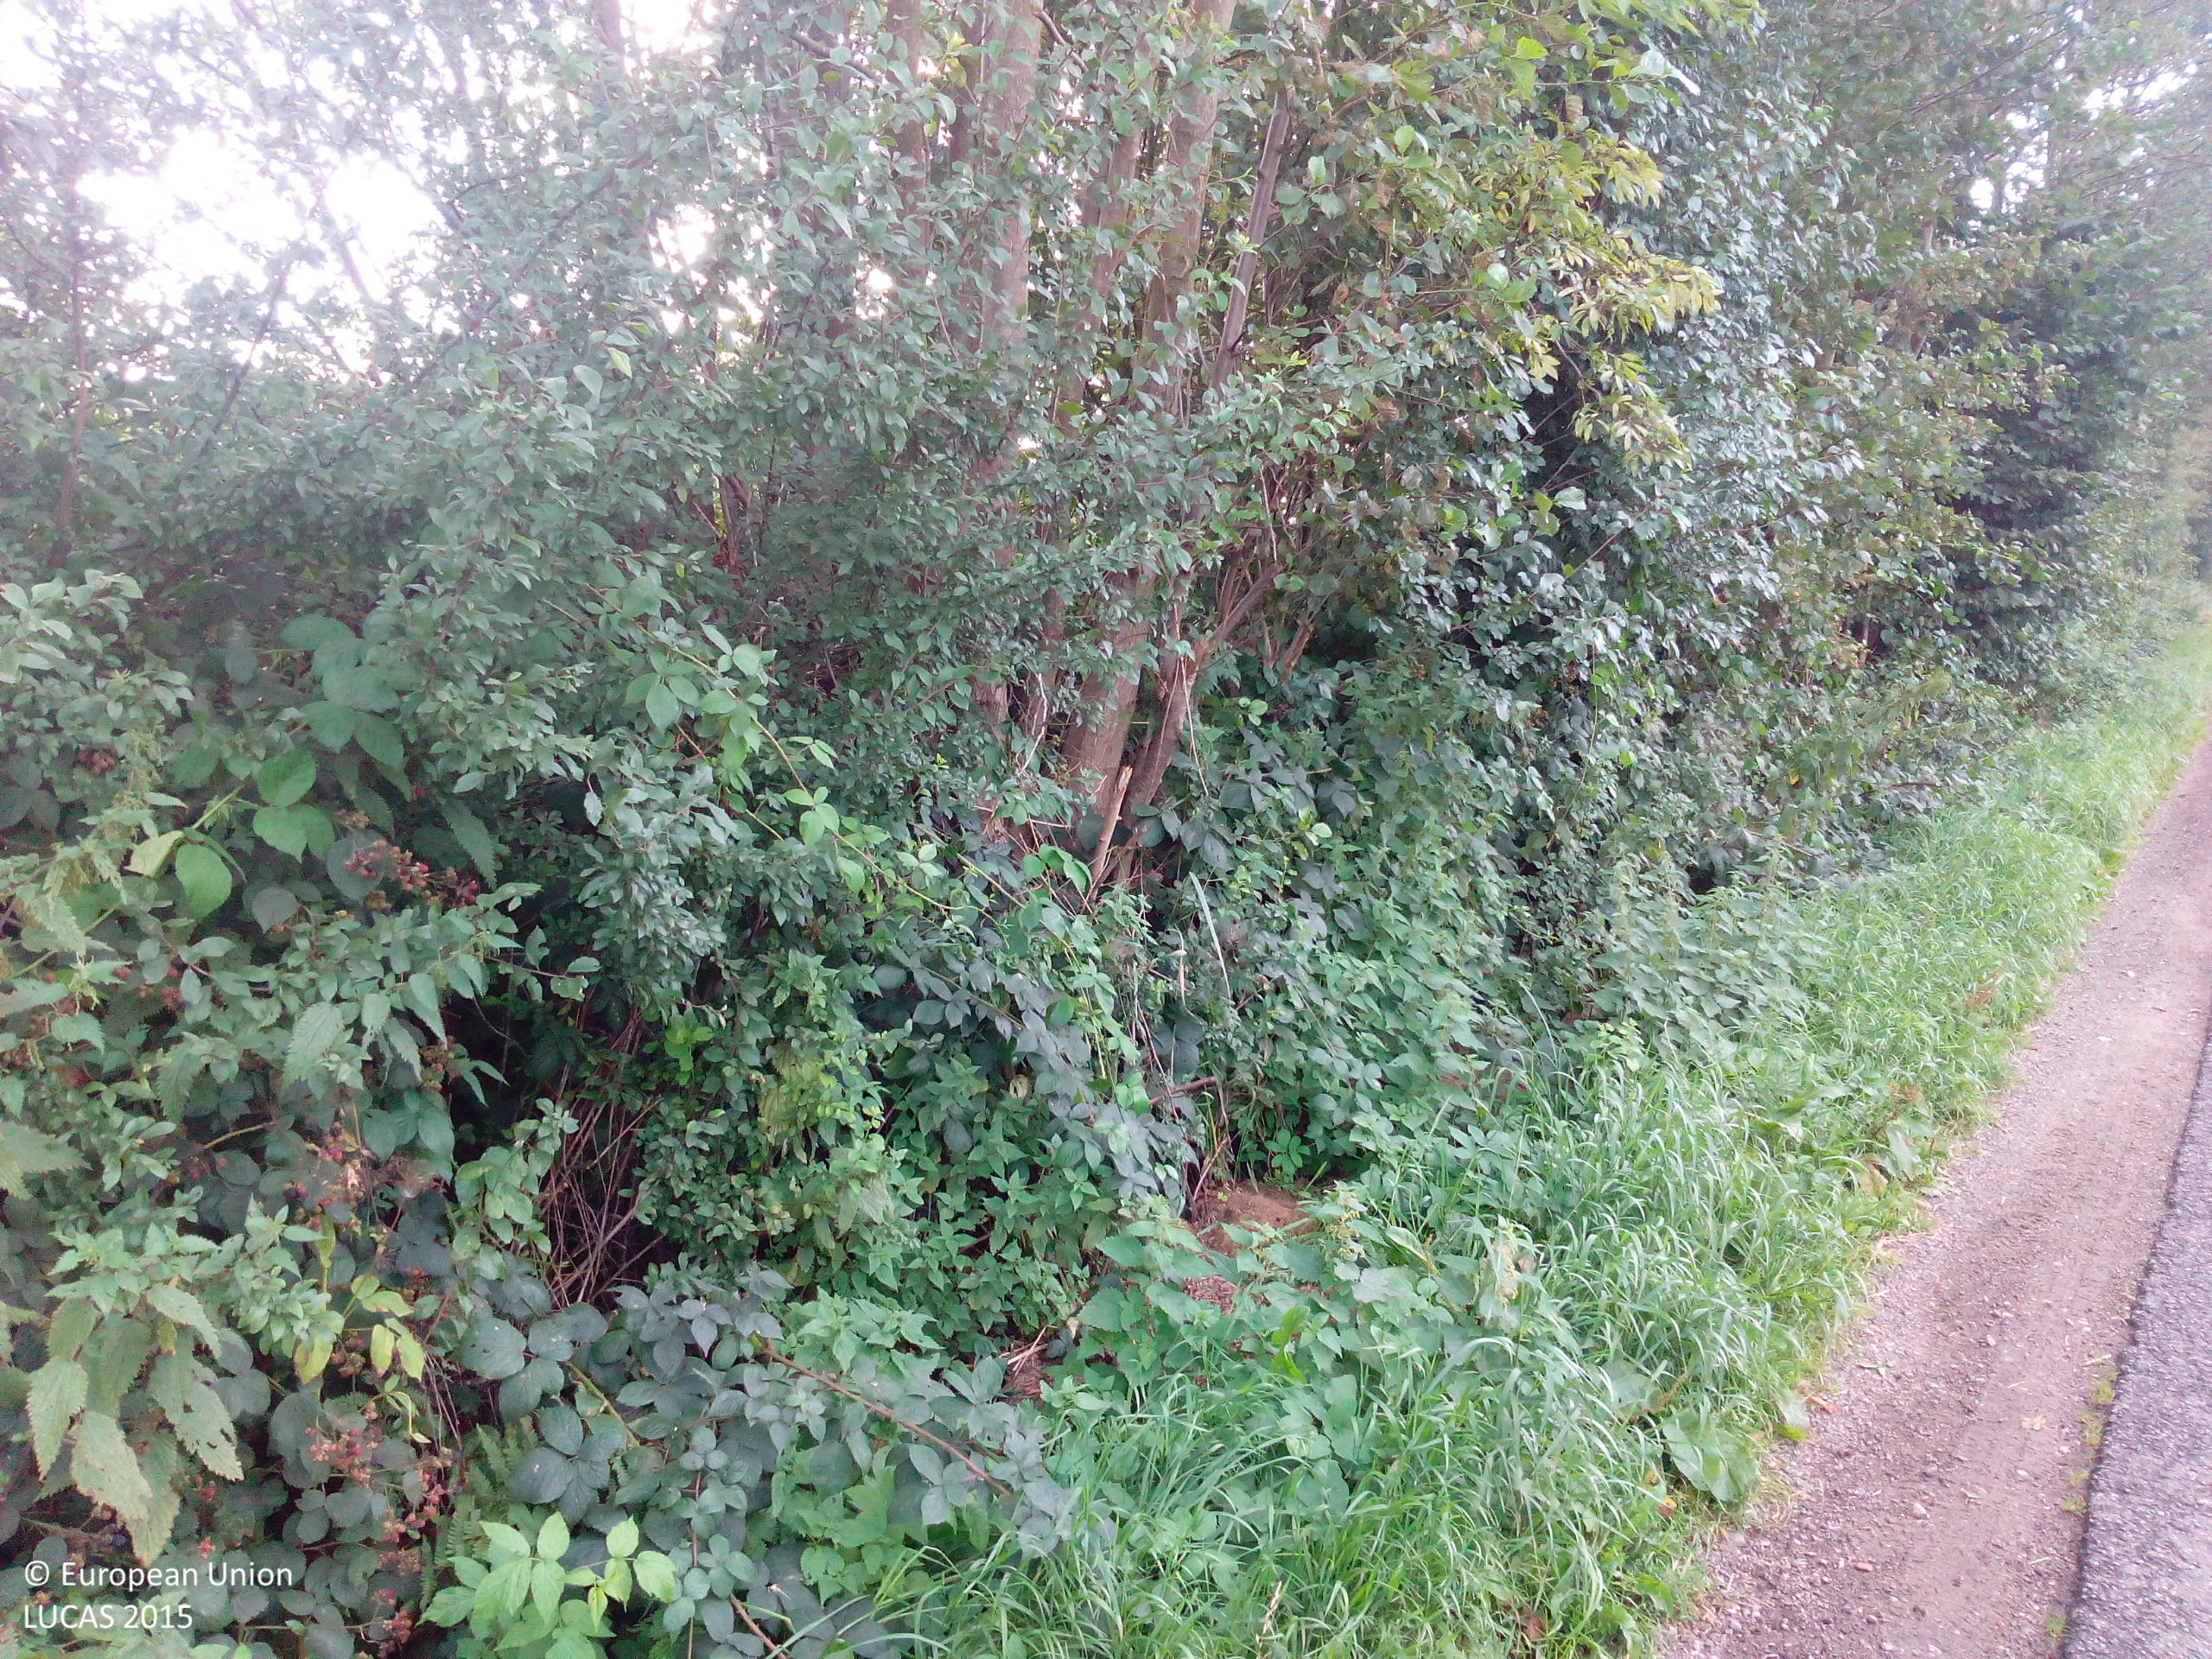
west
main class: Woodland
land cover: Broadleaved woodland
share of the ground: > 75 %
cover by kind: broadleaved forest trees 100 %
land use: Road transport
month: August
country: DE
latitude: 53.7973
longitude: 9.9545
